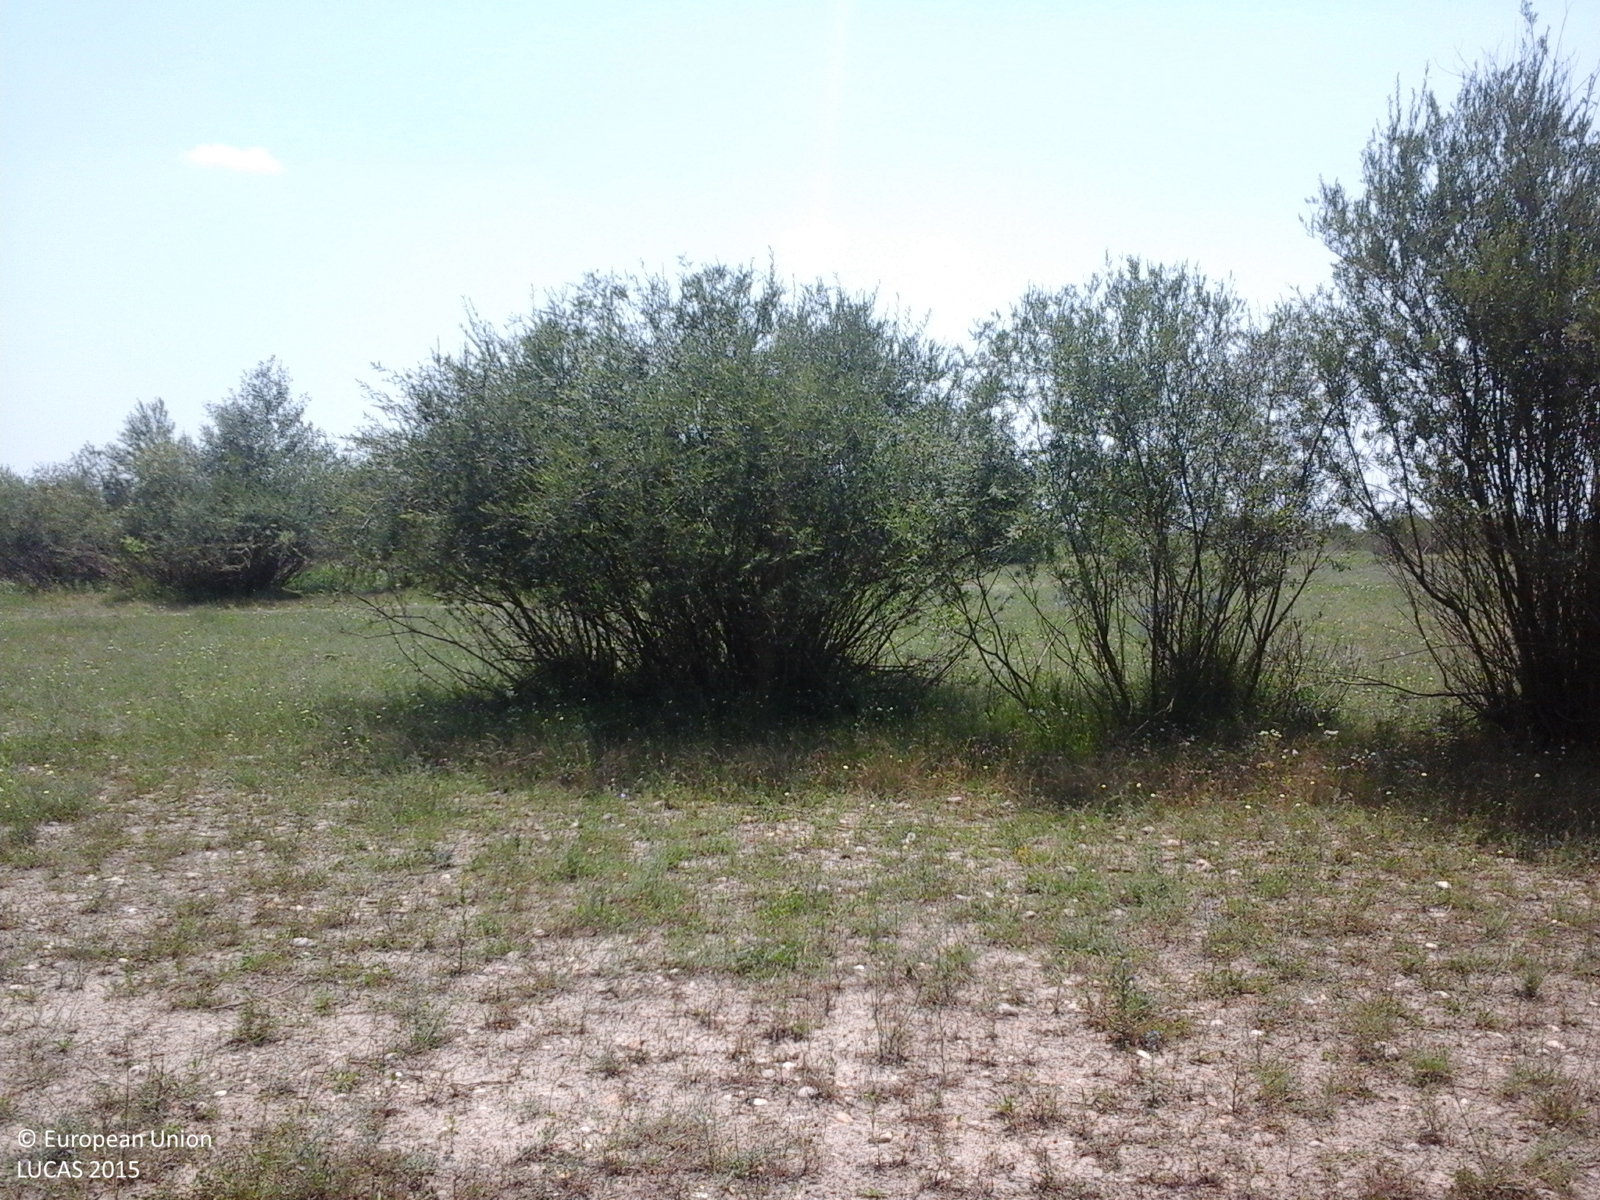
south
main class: Grassland
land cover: Spontaneously vegetated surfaces
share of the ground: 10 - 25 %
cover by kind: herbaceous plants 100 %
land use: Agriculture (excluding fallow land and kitchen gardens)
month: July
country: RO
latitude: 44.7921
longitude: 25.7359
